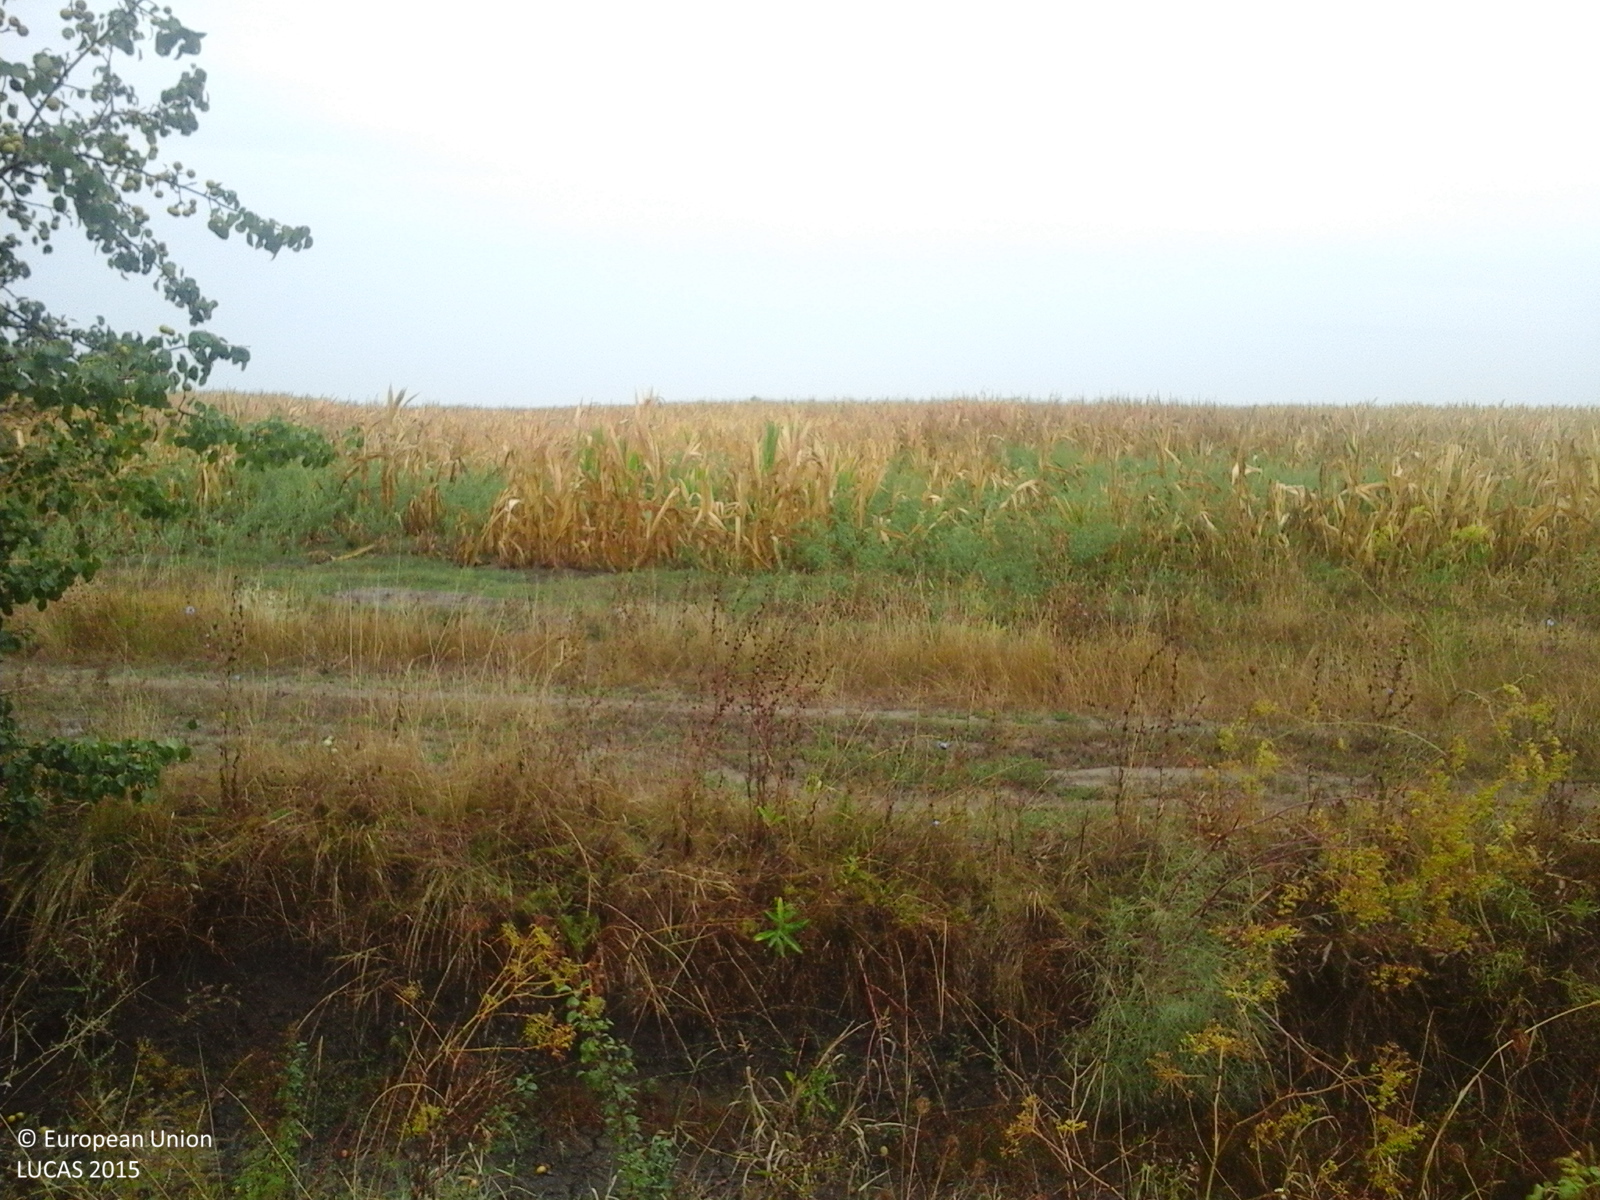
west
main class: Cropland
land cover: Maize
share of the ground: > 75 %
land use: Agriculture (excluding fallow land and kitchen gardens)
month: September
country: RO
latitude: 47.5884
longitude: 22.5985
